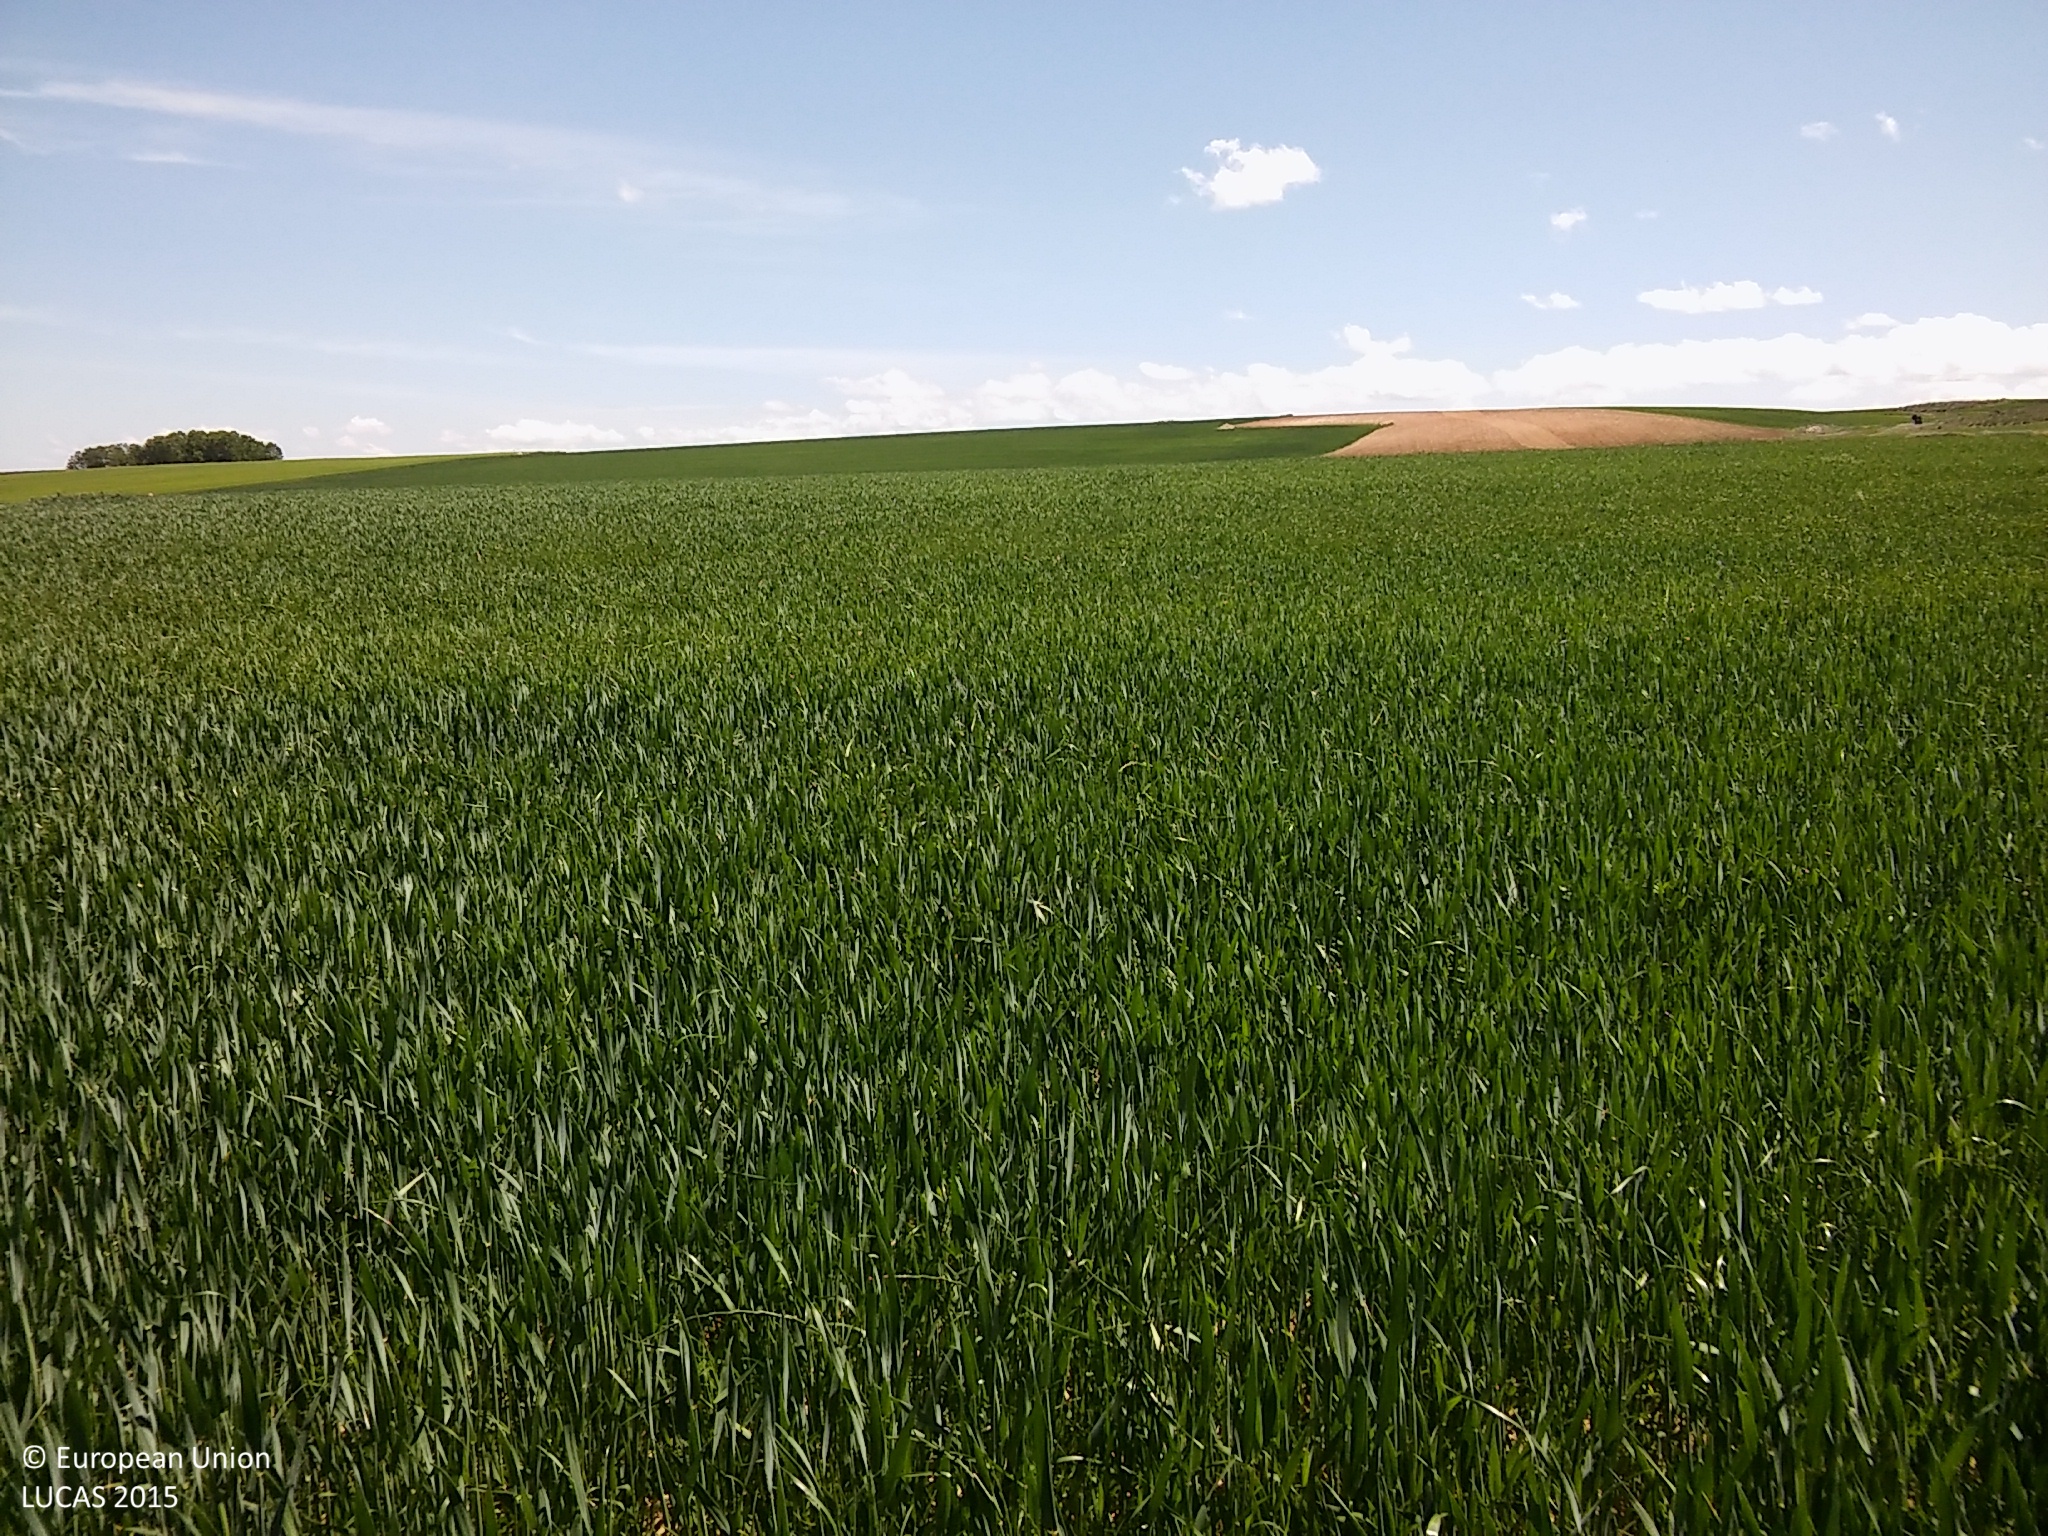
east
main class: Cropland
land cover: Common wheat
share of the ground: > 75 %
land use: Agriculture (excluding fallow land and kitchen gardens)
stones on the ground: < 10 %
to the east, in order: Common wheat; Ditches and canals; Grass margins; Common wheat; Grass margins; Ditches and canals; Grass margins; Common wheat; Grass margins; Ditches and canals; Grass margins; Paved roads, cycling and walking lanes; Grass margins
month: May
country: ES
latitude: 41.1516
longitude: -3.9562
